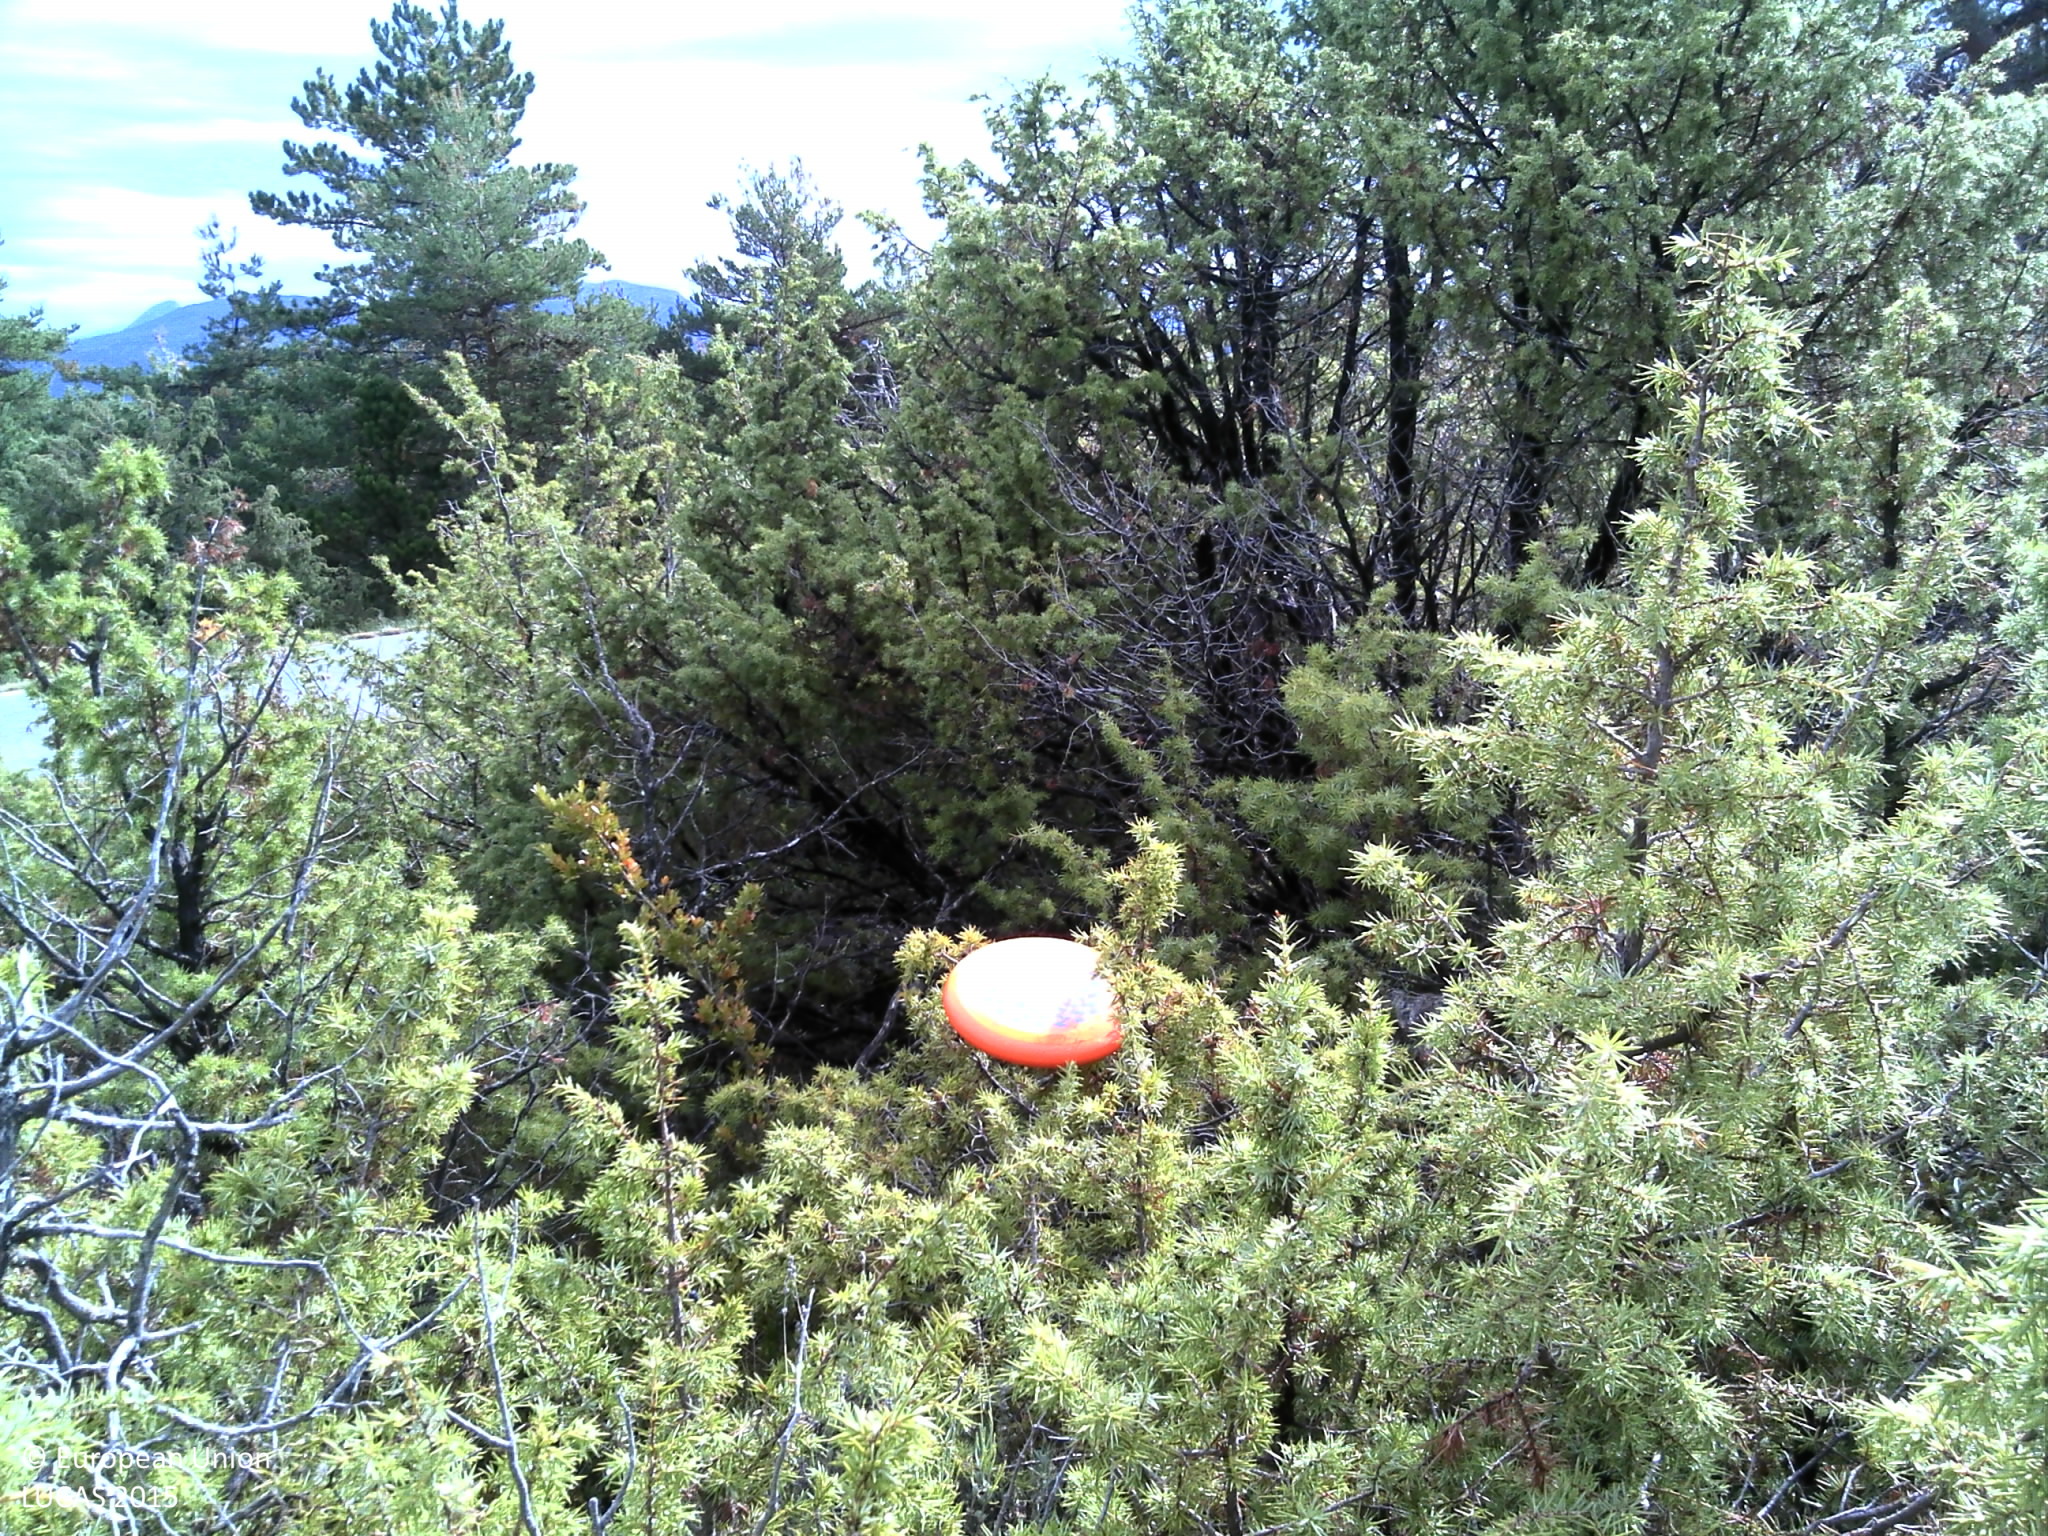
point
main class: Woodland
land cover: Pine dominated coniferous woodland
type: coniferous forest of the mediterranean region
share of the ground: > 75 %
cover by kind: coniferous forest trees 75 %, shrubs 15 %, lichens and mosses 5 %, consolidated bare surface 5 %
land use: Semi-natural and natural areas not in use
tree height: > 5 m
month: September
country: FR
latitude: 43.7471
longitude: 6.4192
